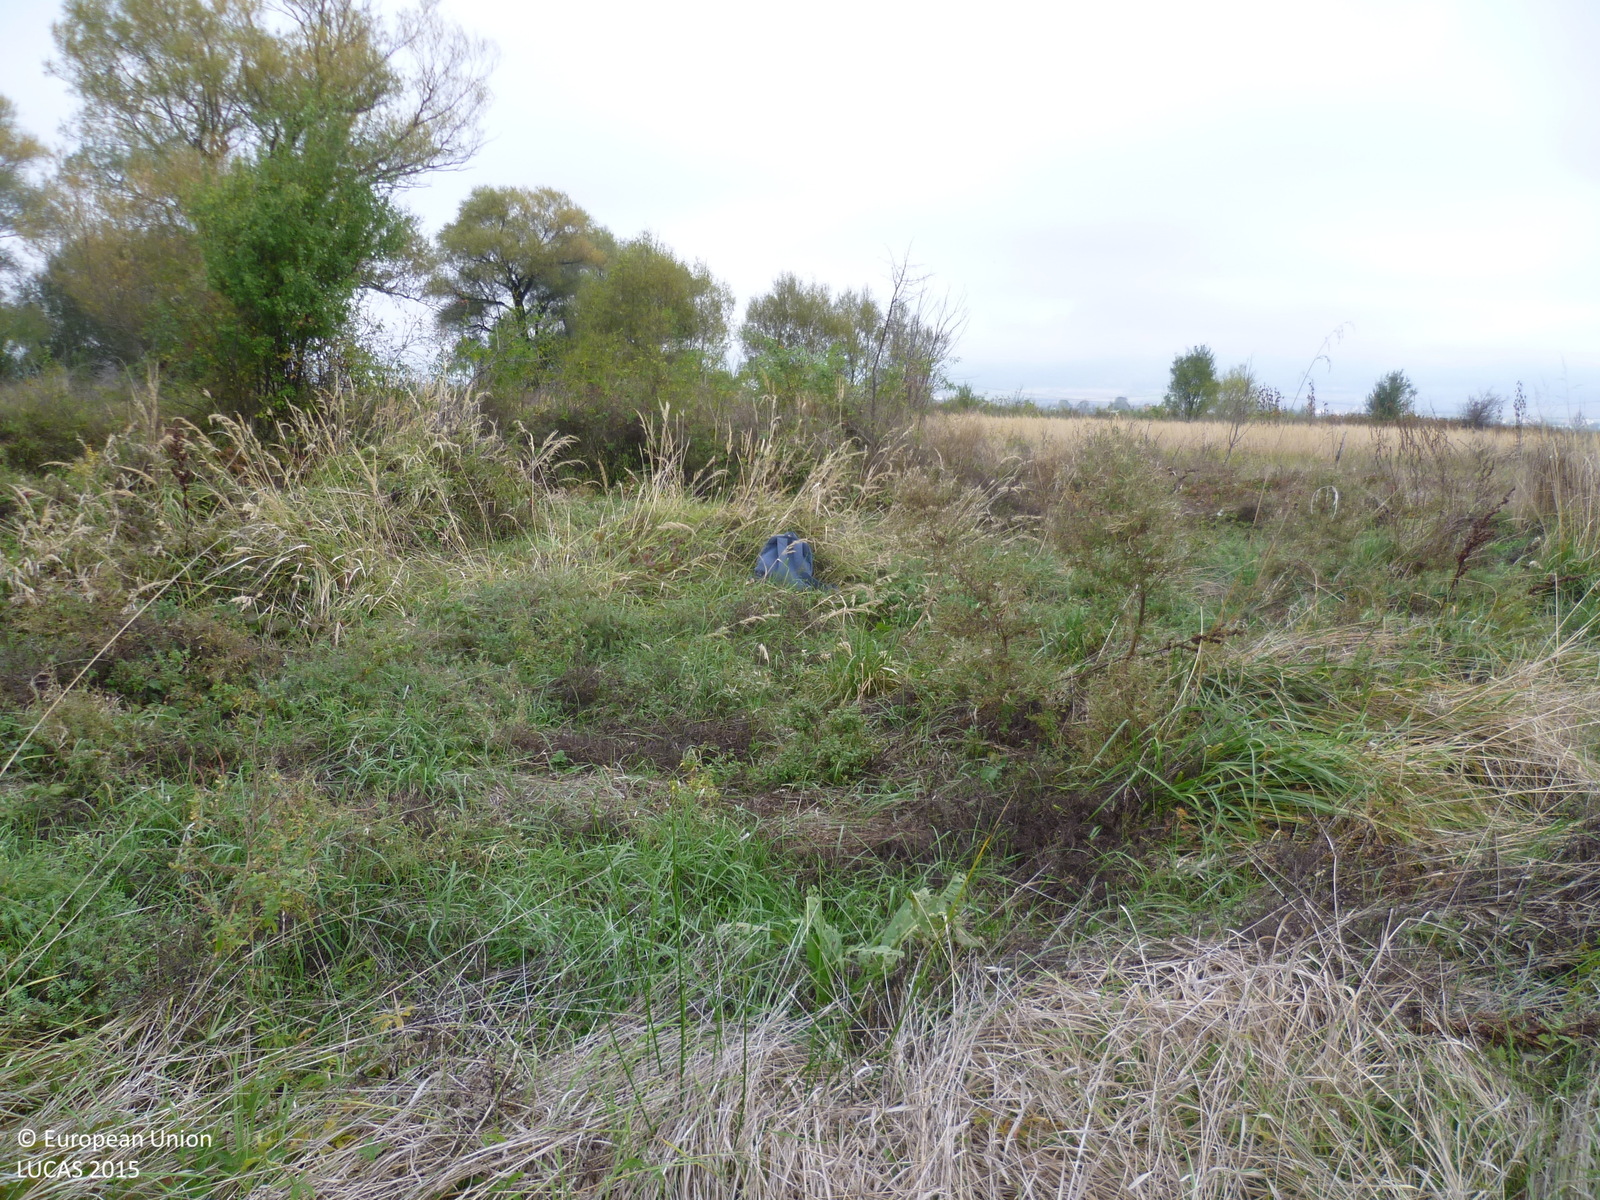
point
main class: Grassland
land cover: Grassland with sparse tree/shrub cover
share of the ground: > 75 %
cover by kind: herbaceous plants 90 %, broadleaved forest trees 5 %, shrubs 5 %
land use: Semi-natural and natural areas not in use
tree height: > 5 m
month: October
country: BG
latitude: 42.4200
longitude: 23.7834
